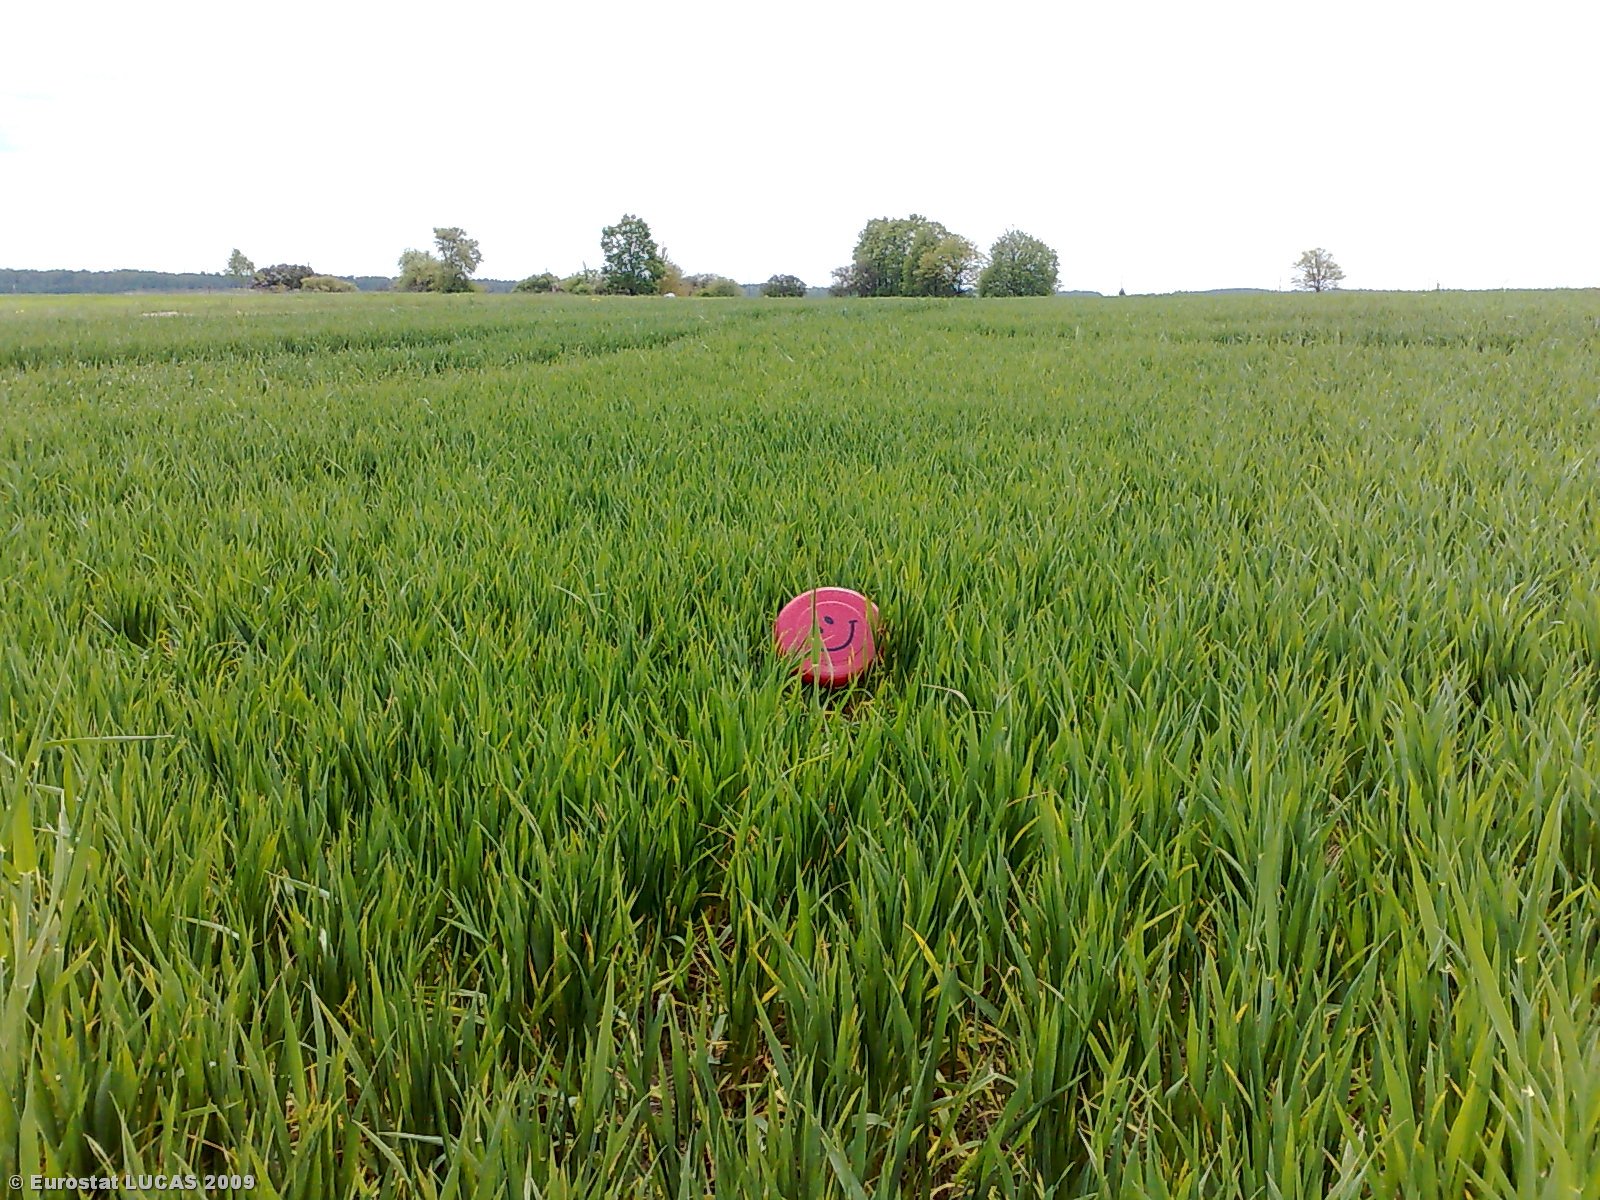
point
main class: Cropland
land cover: Common wheat
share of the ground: > 75 %
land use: Agriculture (excluding fallow land and kitchen gardens)
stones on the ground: < 10 %
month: May
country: LT
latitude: 55.6881
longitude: 23.8446
